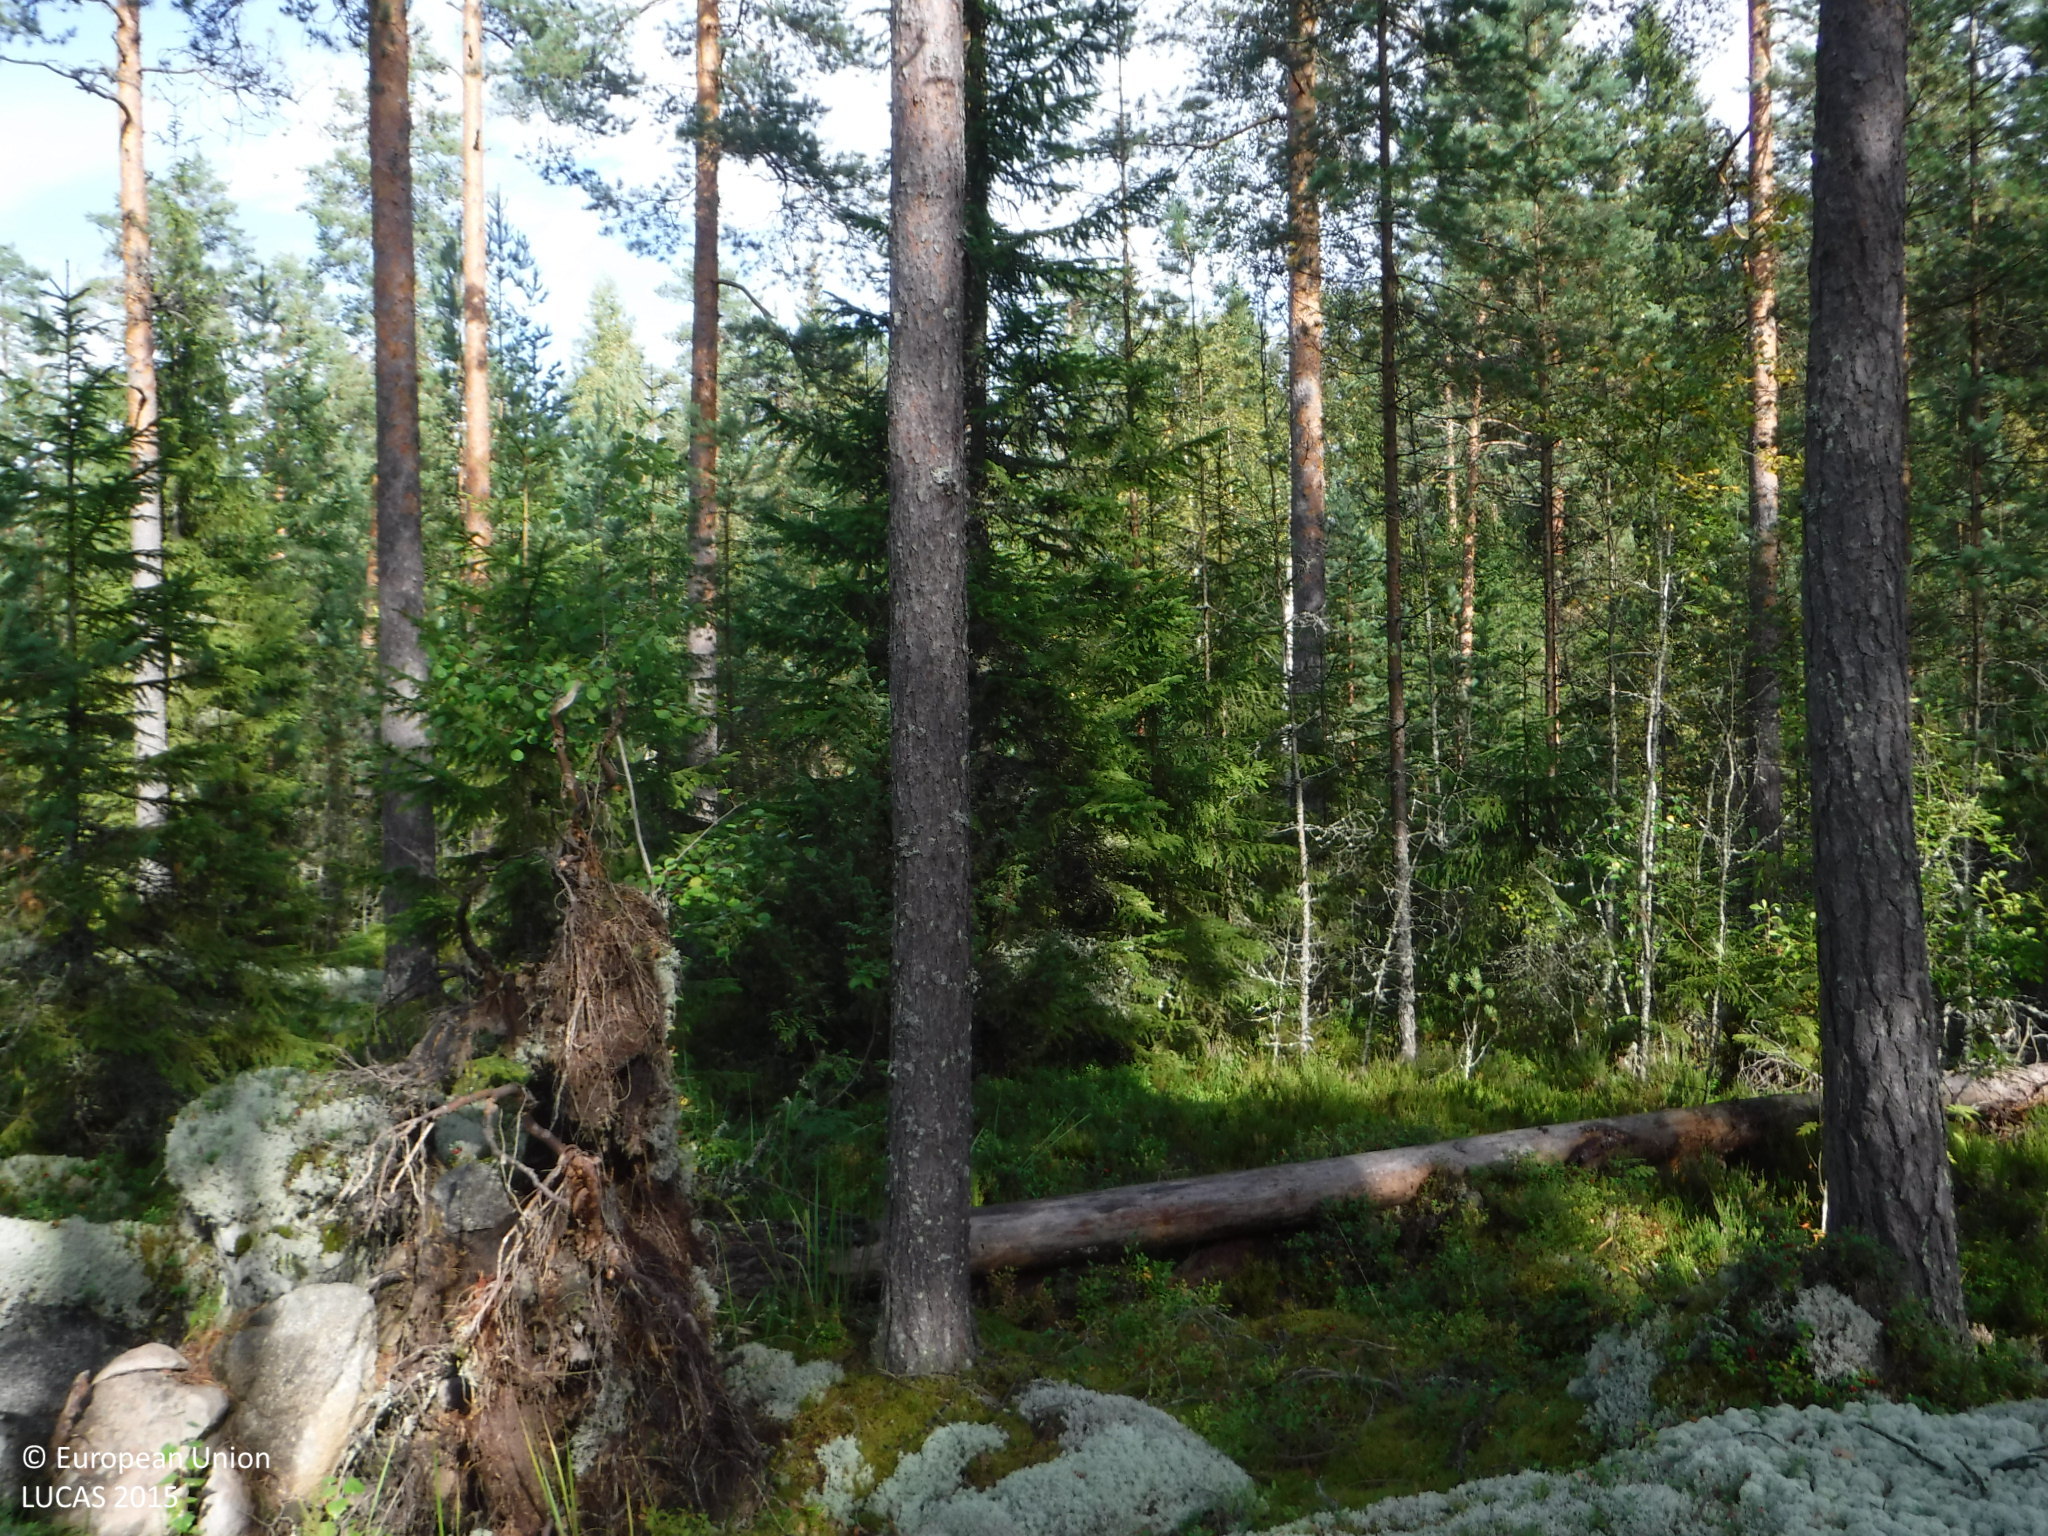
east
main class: Woodland
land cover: Pine dominated coniferous woodland
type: boreal forest
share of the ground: 25 - 50 %
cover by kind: lichens and mosses 45 %, coniferous forest trees 30 %, shrubs 25 %
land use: Forestry
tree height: > 5 m
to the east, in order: Pine dominated coniferous woodland; Groves; Paved roads, cycling and walking lanes; Groves; Other mixed woodland; Ditches and canals; Other coniferous woodland; Pine dominated mixed woodland; Ditches and canals; Pine dominated mixed woodland; Other coniferous woodland
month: September
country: FI
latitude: 61.3656
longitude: 22.6179
